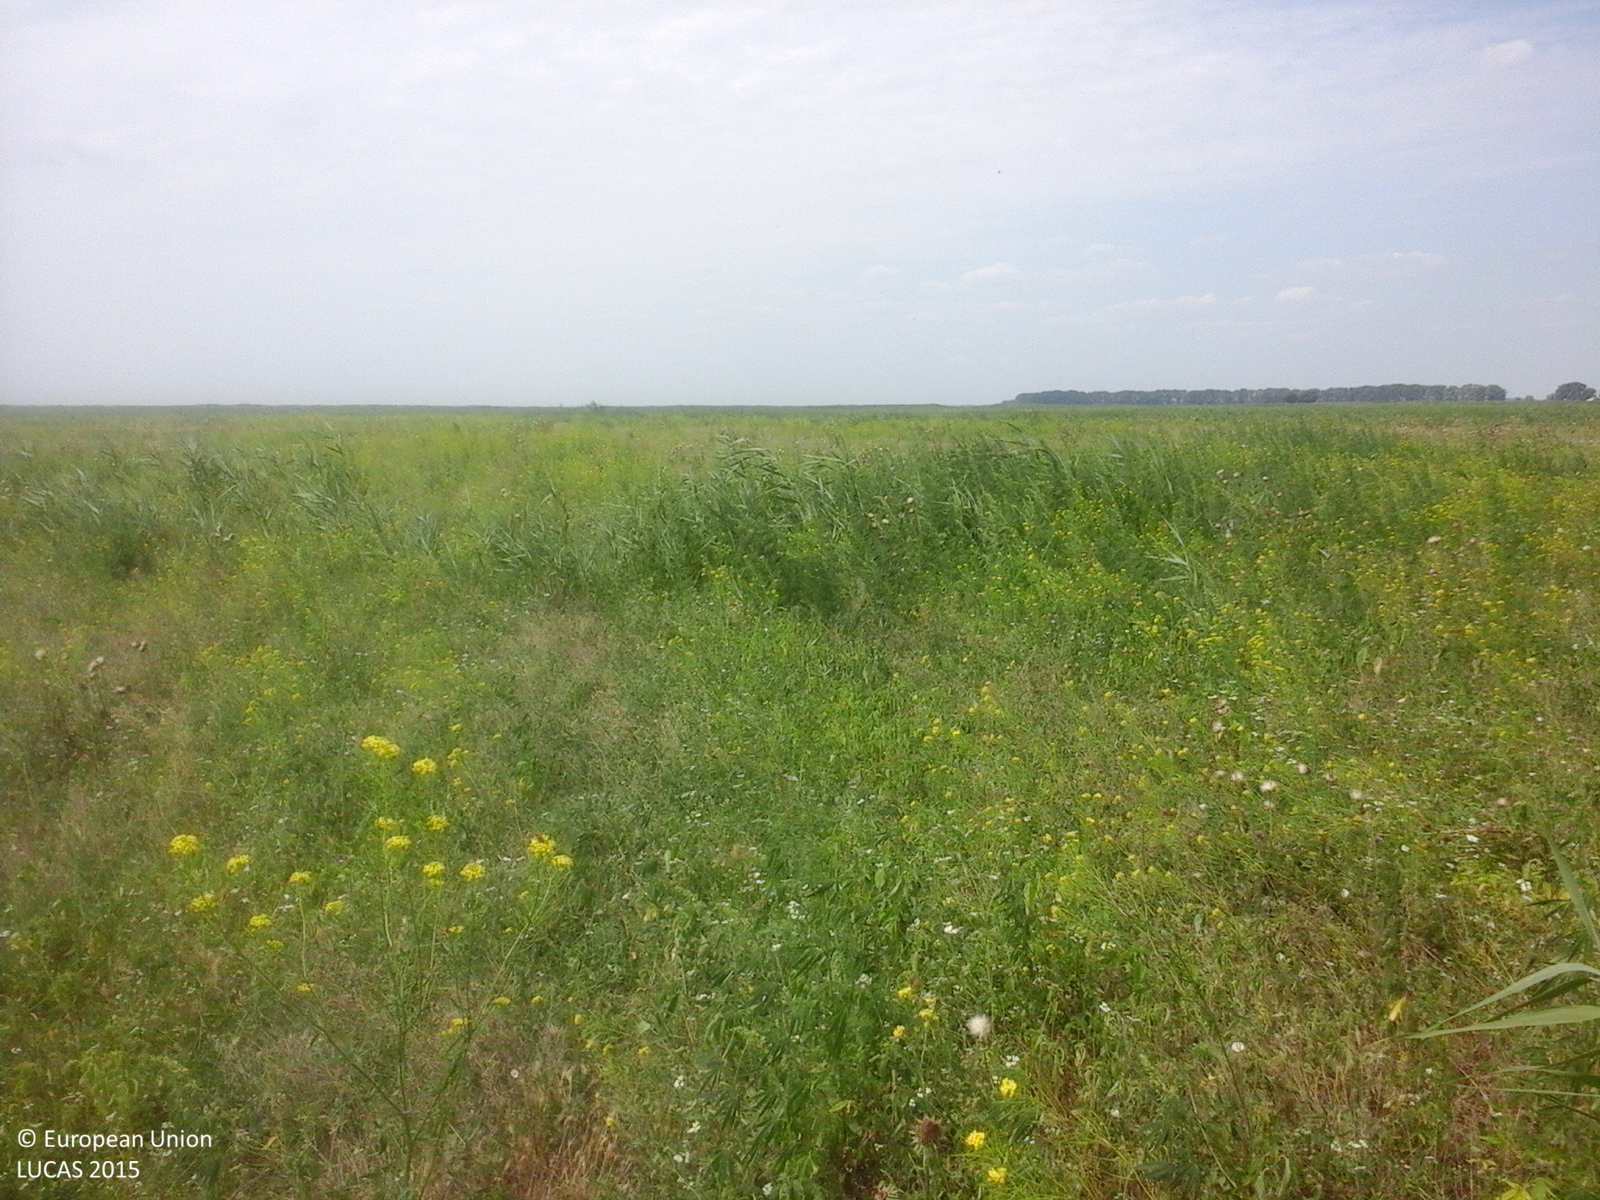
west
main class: Grassland
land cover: Spontaneously vegetated surfaces
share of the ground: > 75 %
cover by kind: herbaceous plants 100 %
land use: Semi-natural and natural areas not in use
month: August
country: RO
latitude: 45.2999
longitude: 29.0634
